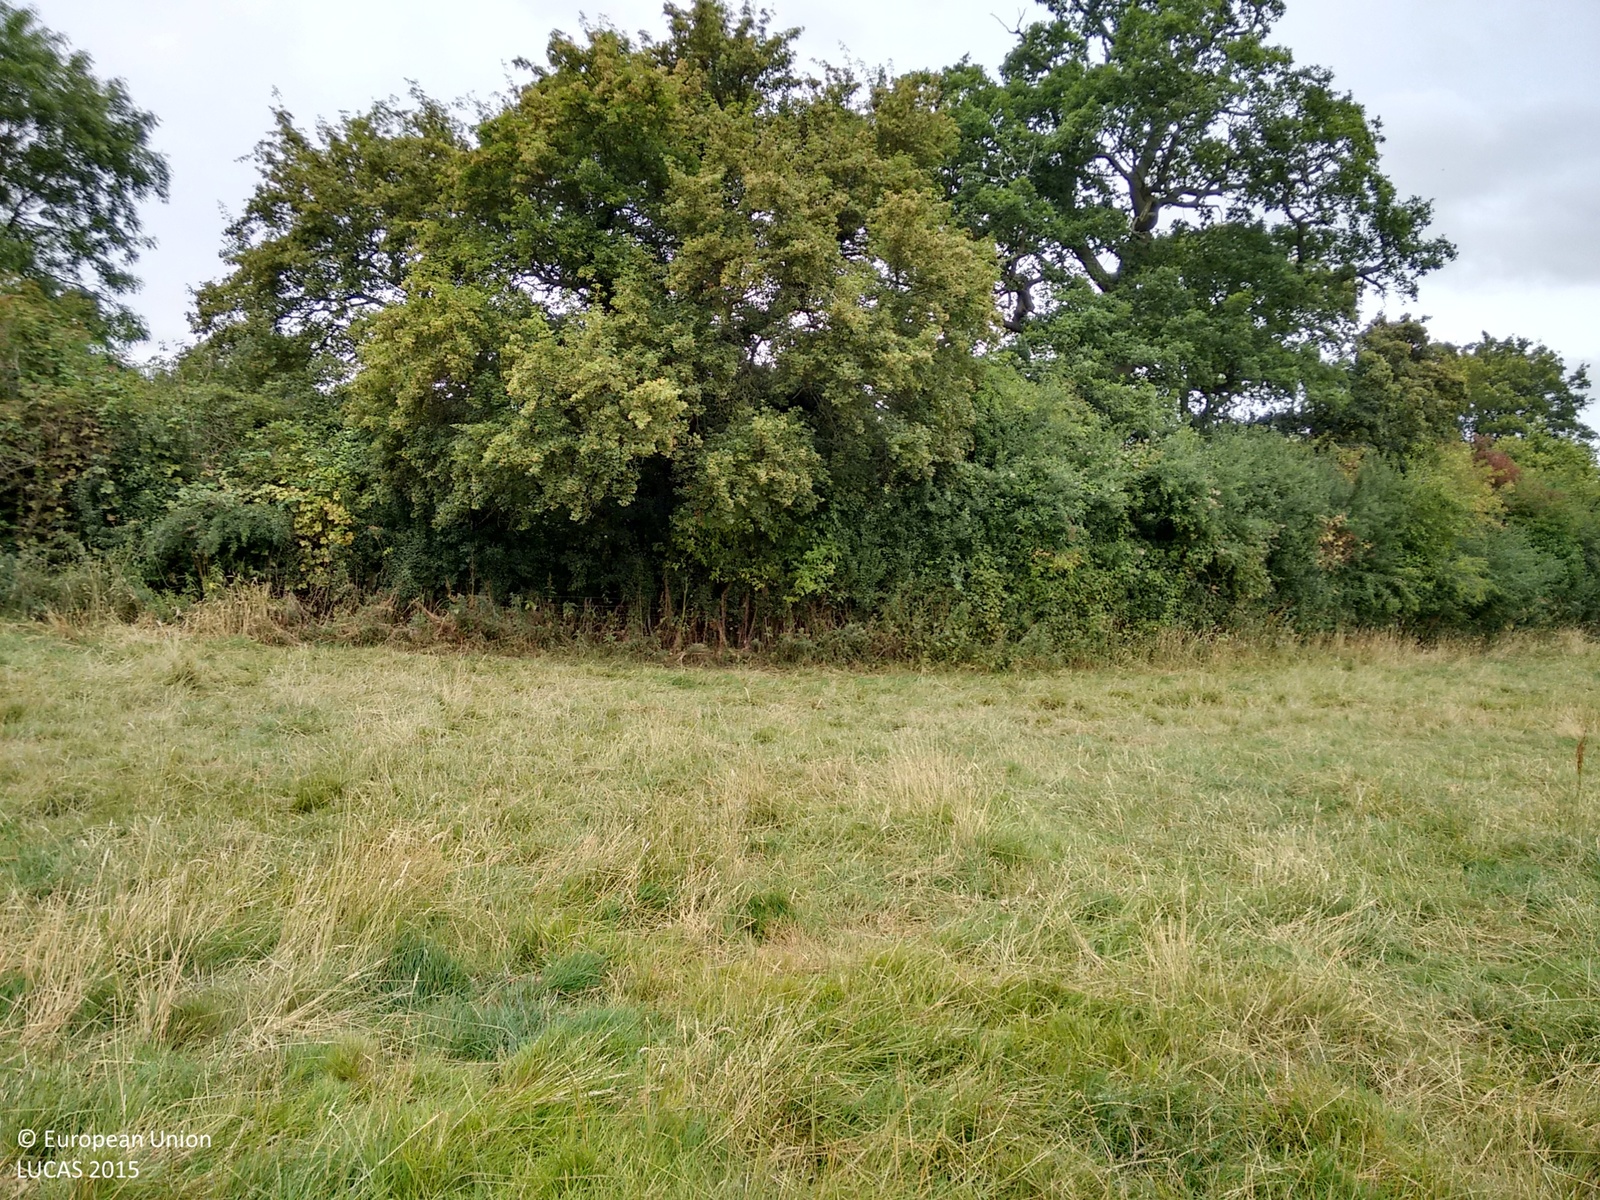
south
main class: Grassland
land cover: Grassland without tree/shrub cover
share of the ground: > 75 %
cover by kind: herbaceous plants 100 %
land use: Agriculture (excluding fallow land and kitchen gardens)
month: August
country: GB
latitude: 52.1161
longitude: -1.2191
